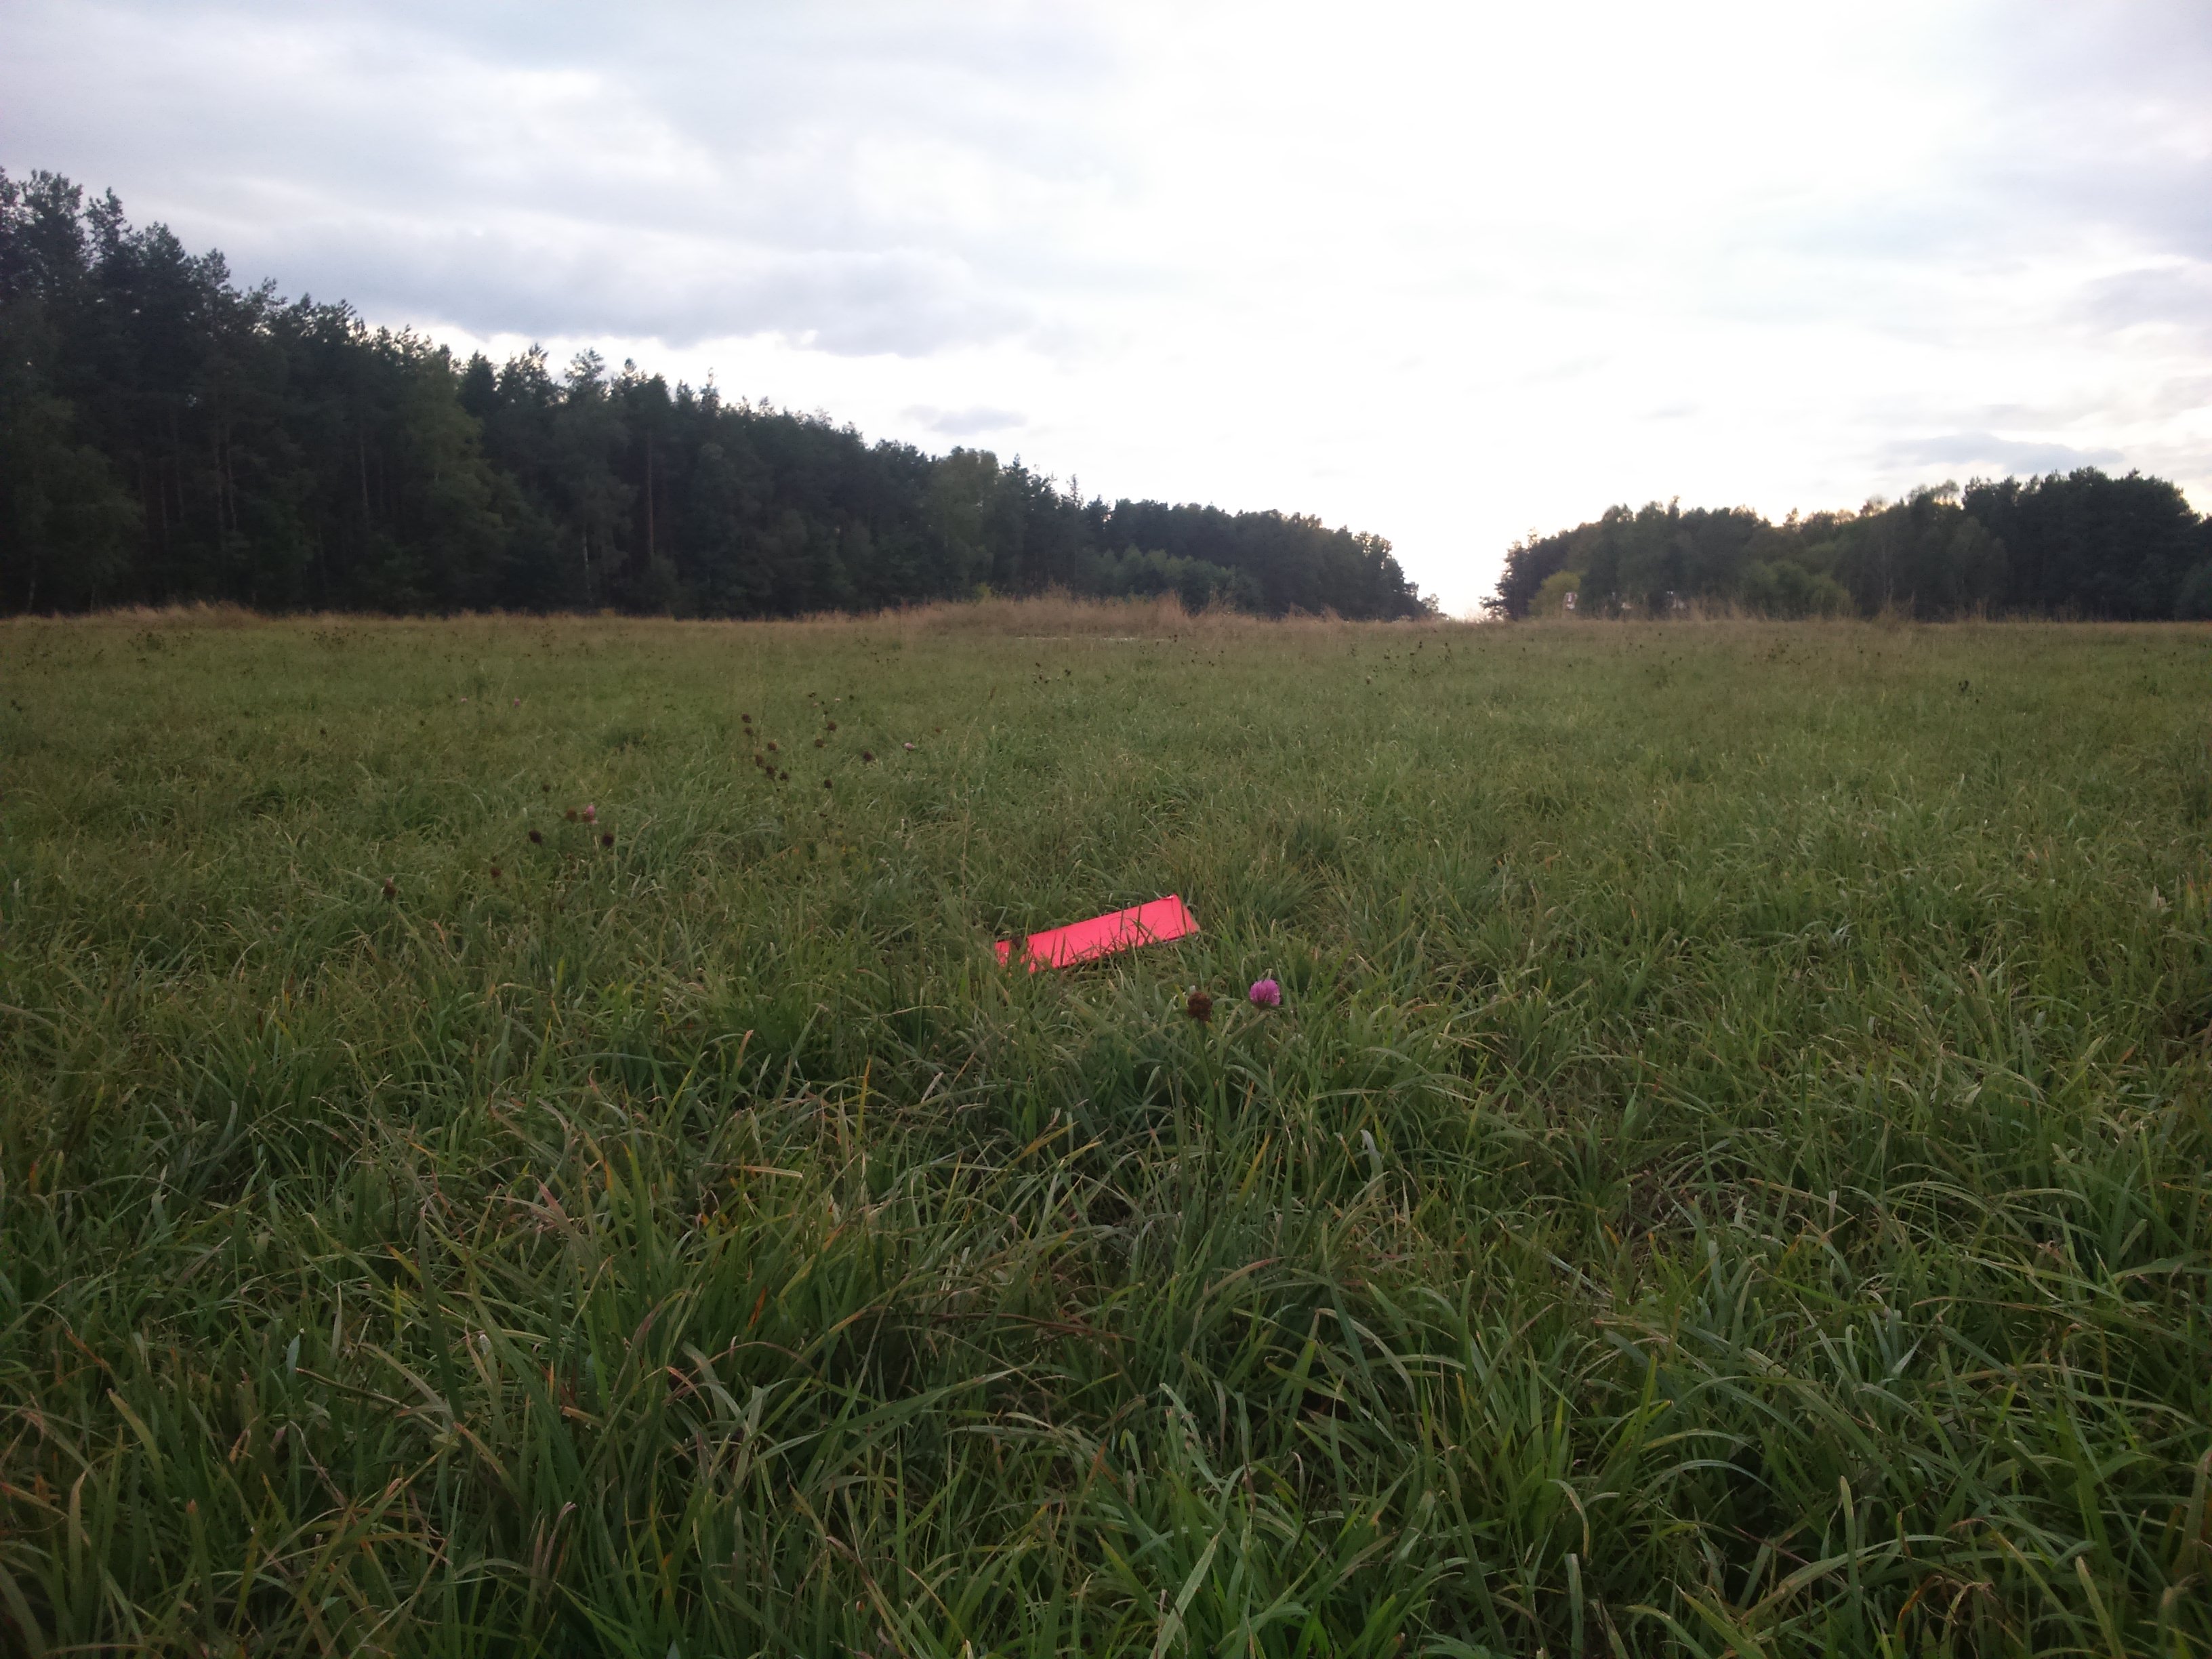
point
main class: Grassland
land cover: Grassland without tree/shrub cover
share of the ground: > 75 %
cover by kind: herbaceous plants 100 %
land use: Agriculture (excluding fallow land and kitchen gardens)
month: September
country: PL
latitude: 52.2690
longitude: 22.0609
